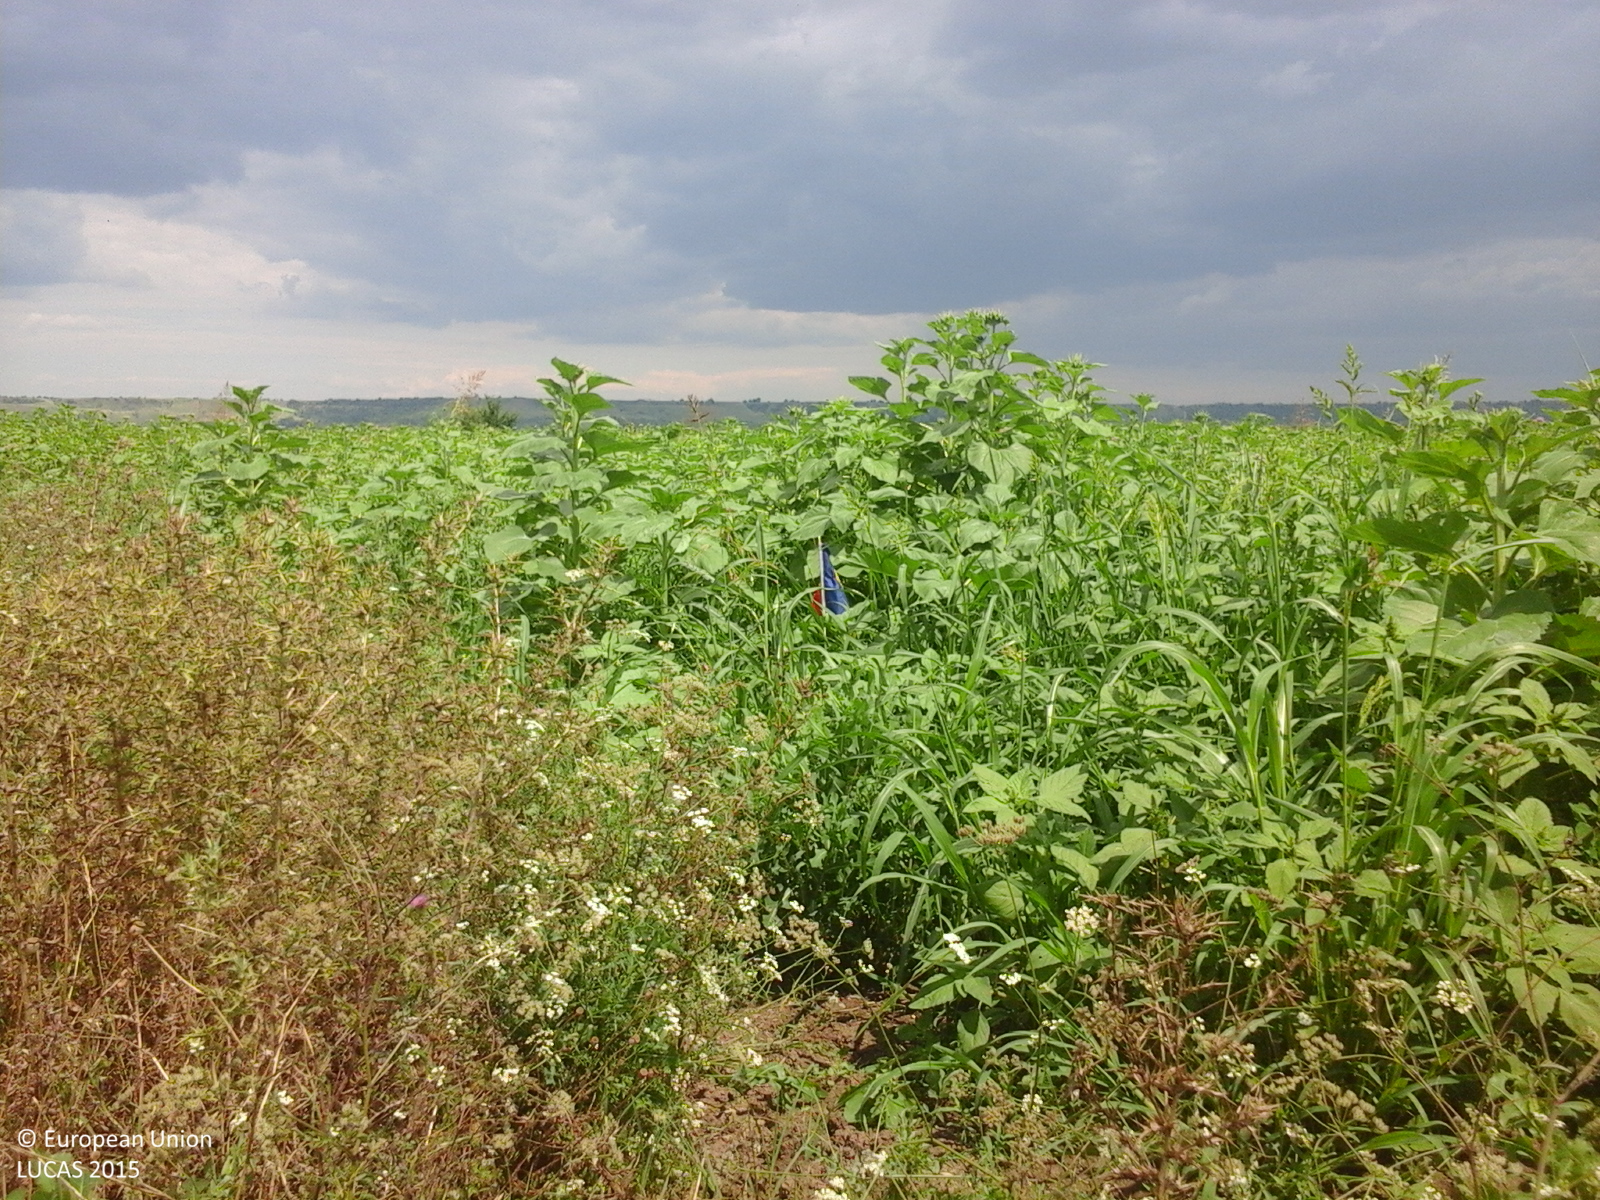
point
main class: Cropland
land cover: Sunflower
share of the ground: > 75 %
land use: Agriculture (excluding fallow land and kitchen gardens)
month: July
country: RO
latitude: 44.0213
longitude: 24.6278
